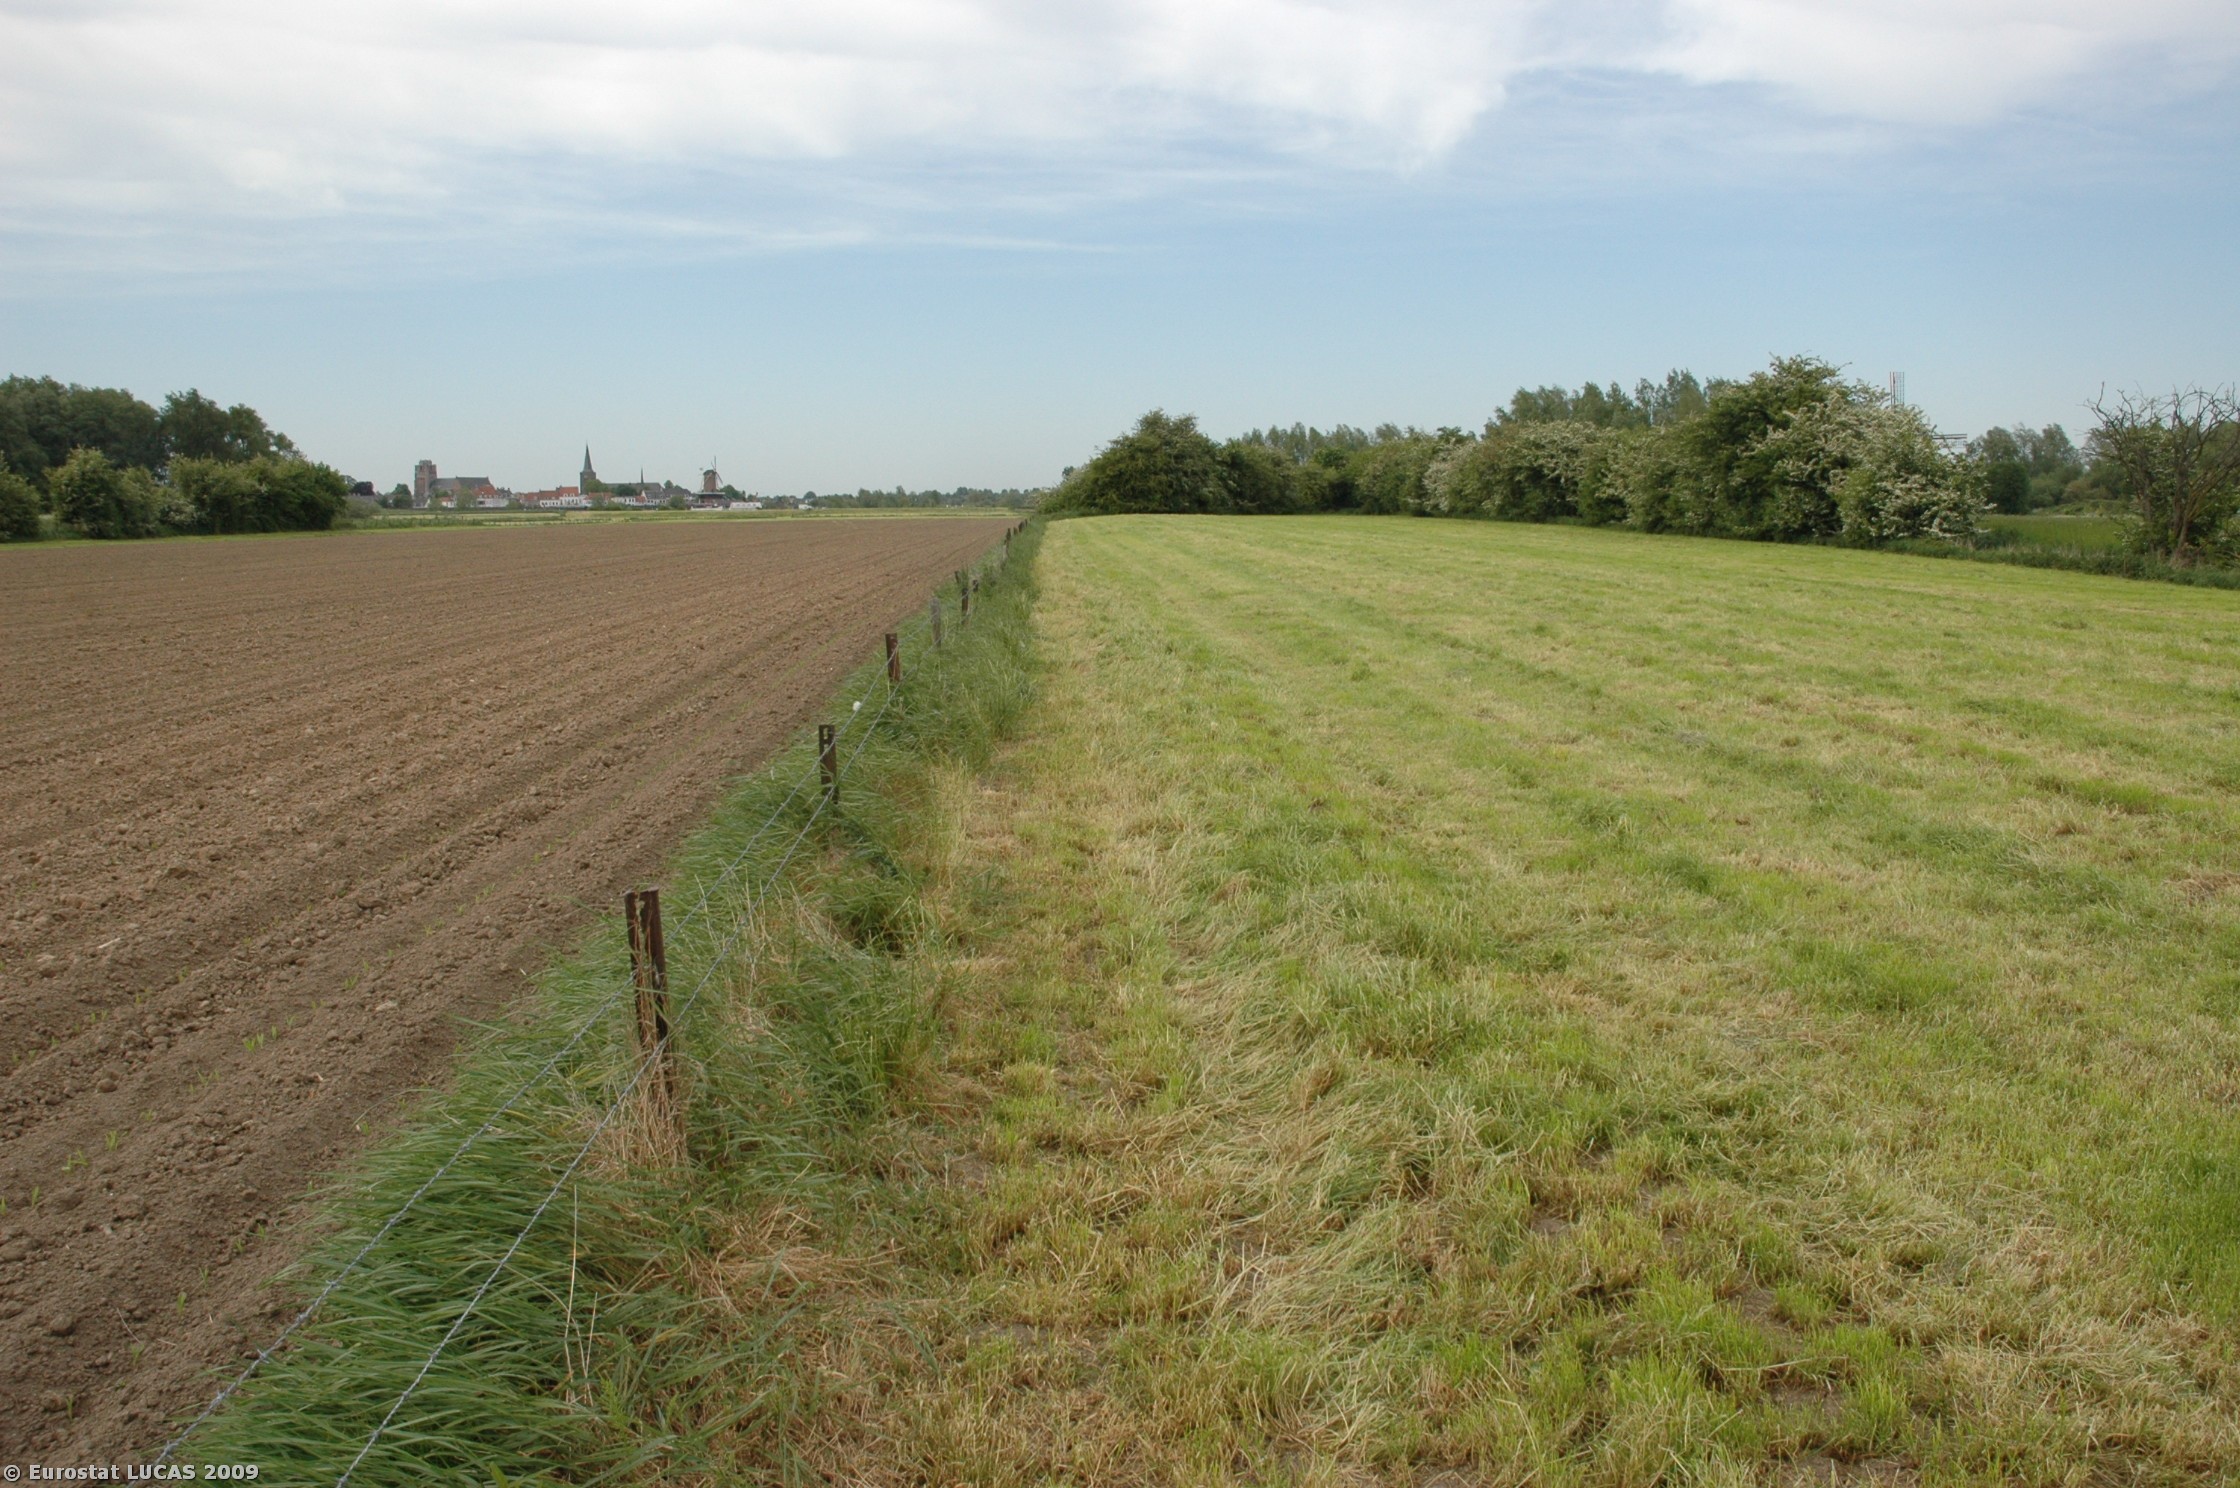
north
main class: Grassland
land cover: Grassland without tree/shrub cover
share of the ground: > 75 %
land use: Agriculture (excluding fallow land and kitchen gardens)
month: May
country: NL
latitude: 51.9626
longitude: 5.3554
